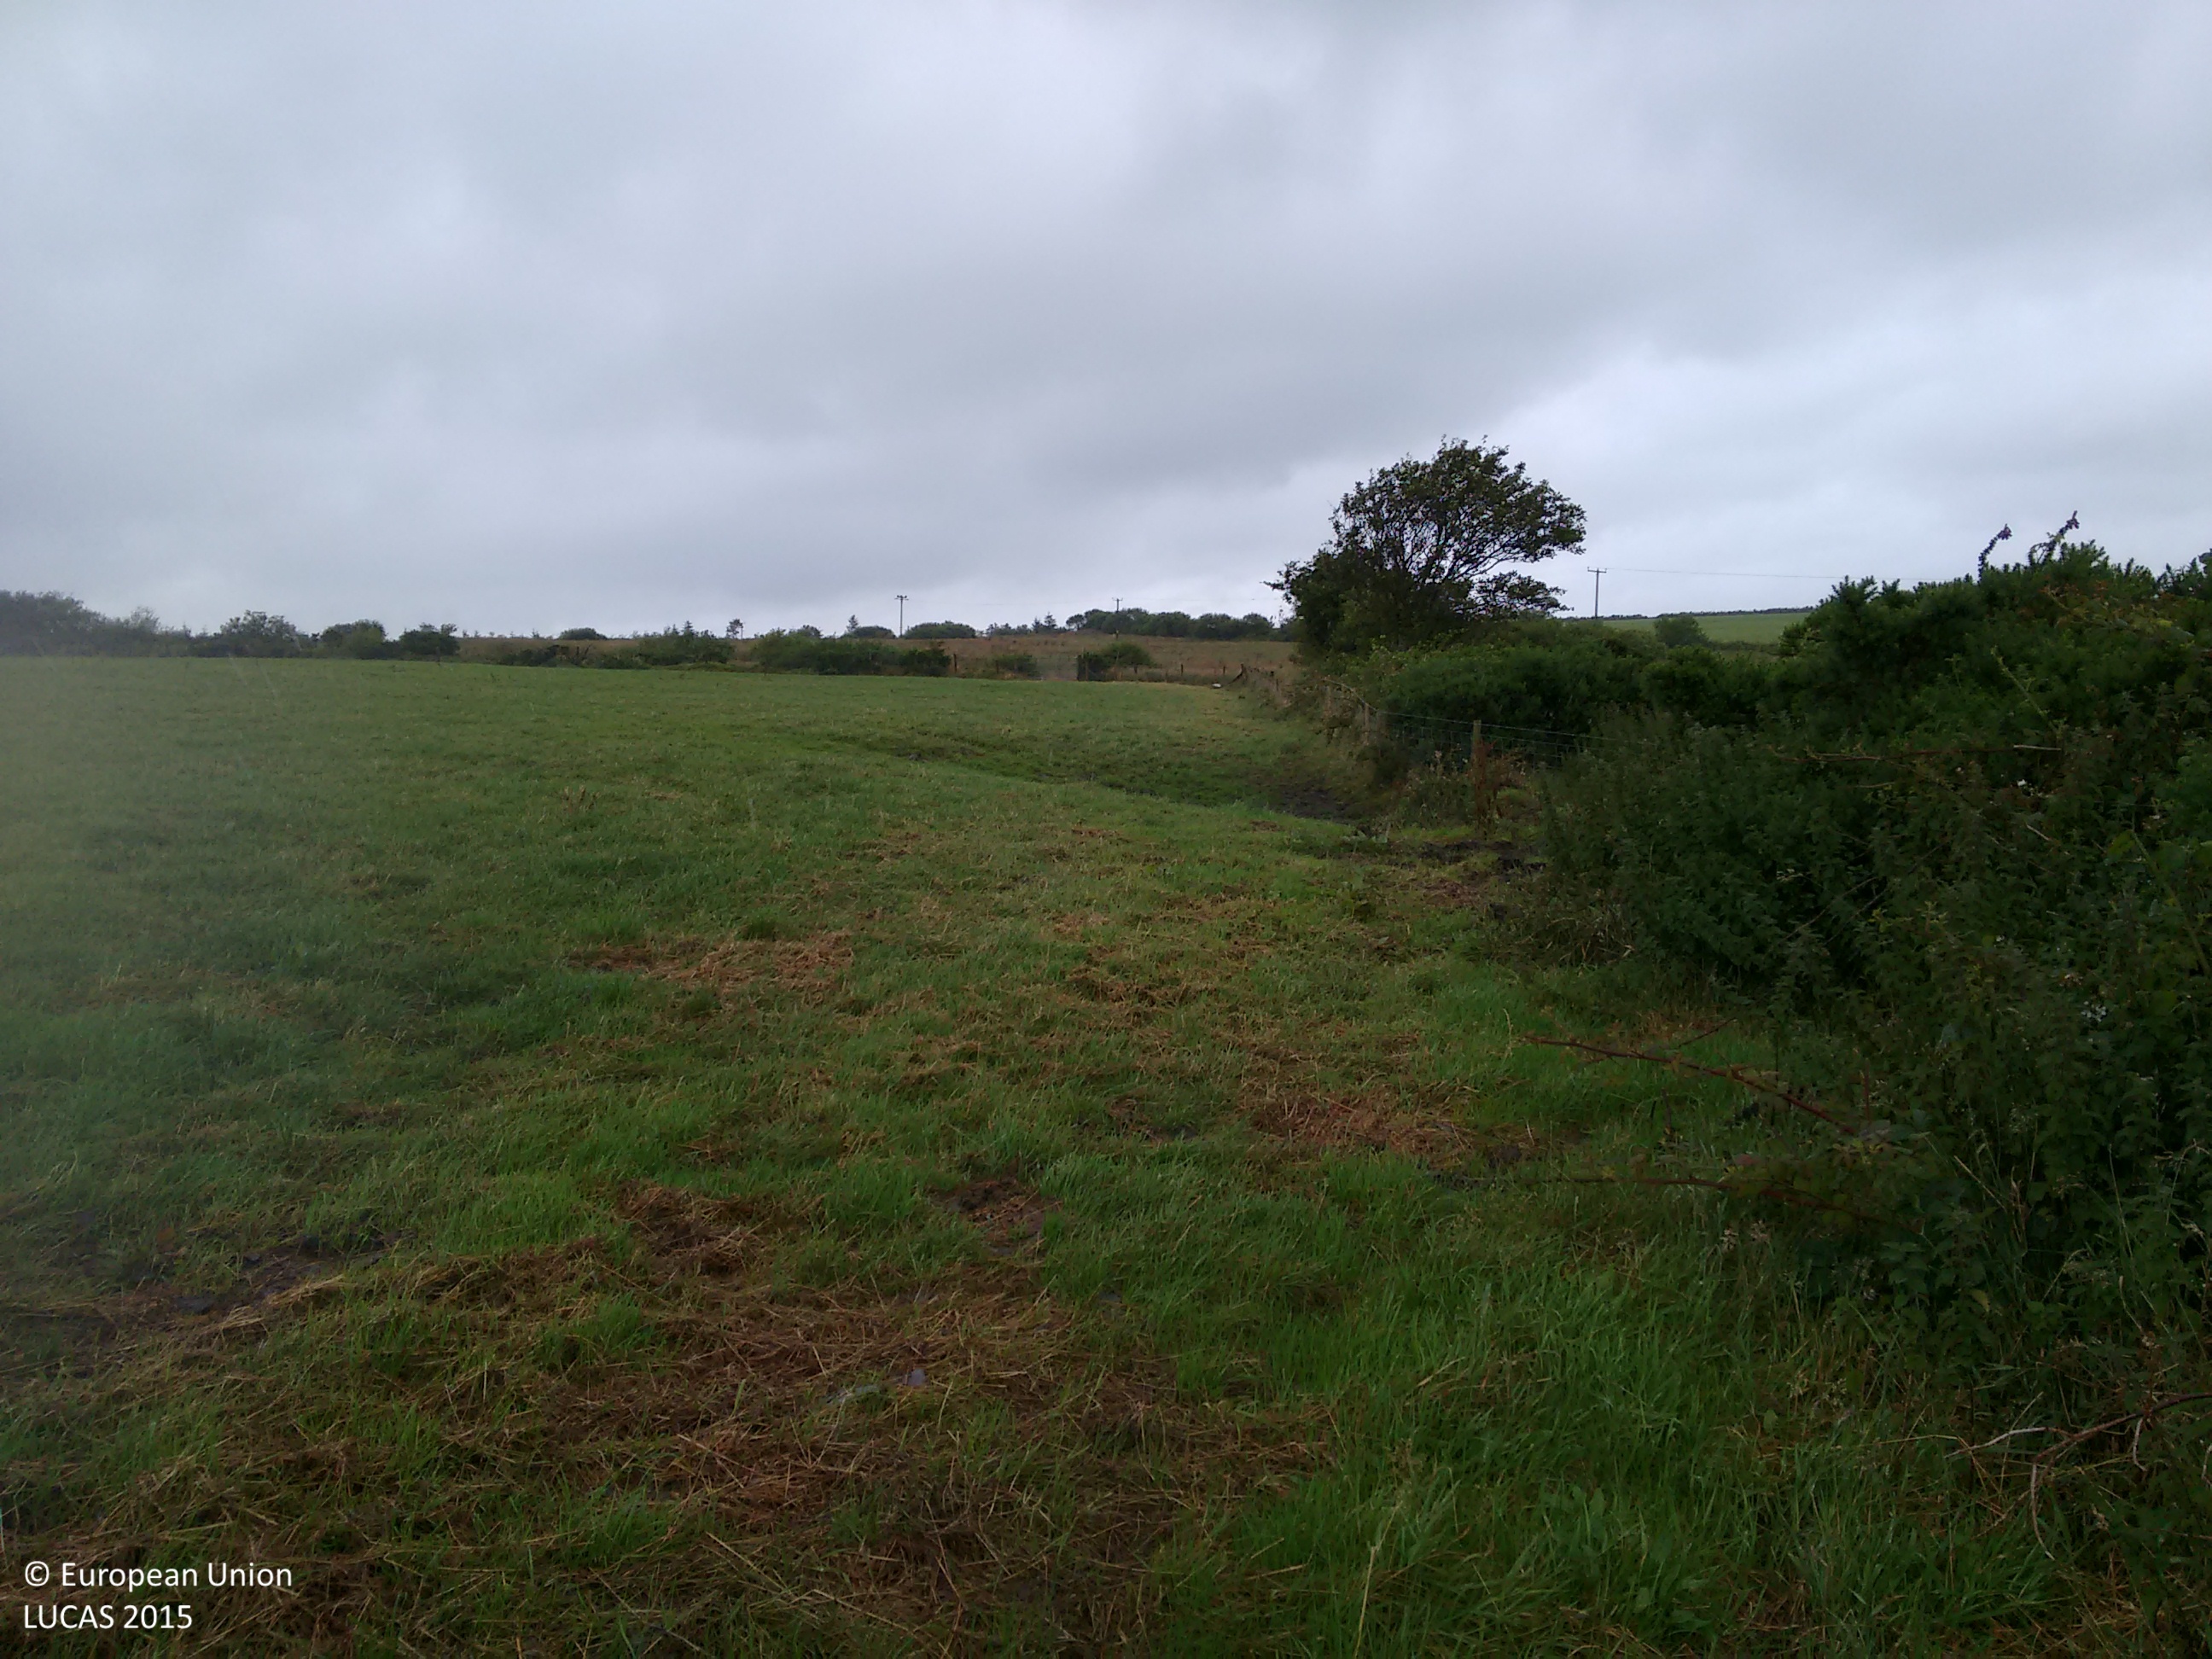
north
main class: Grassland
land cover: Grassland without tree/shrub cover
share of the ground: > 75 %
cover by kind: herbaceous plants 80 %, unconsolidated bare surface 20 %
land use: Agriculture (excluding fallow land and kitchen gardens)
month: August
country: GB
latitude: 51.9670
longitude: -4.4112
